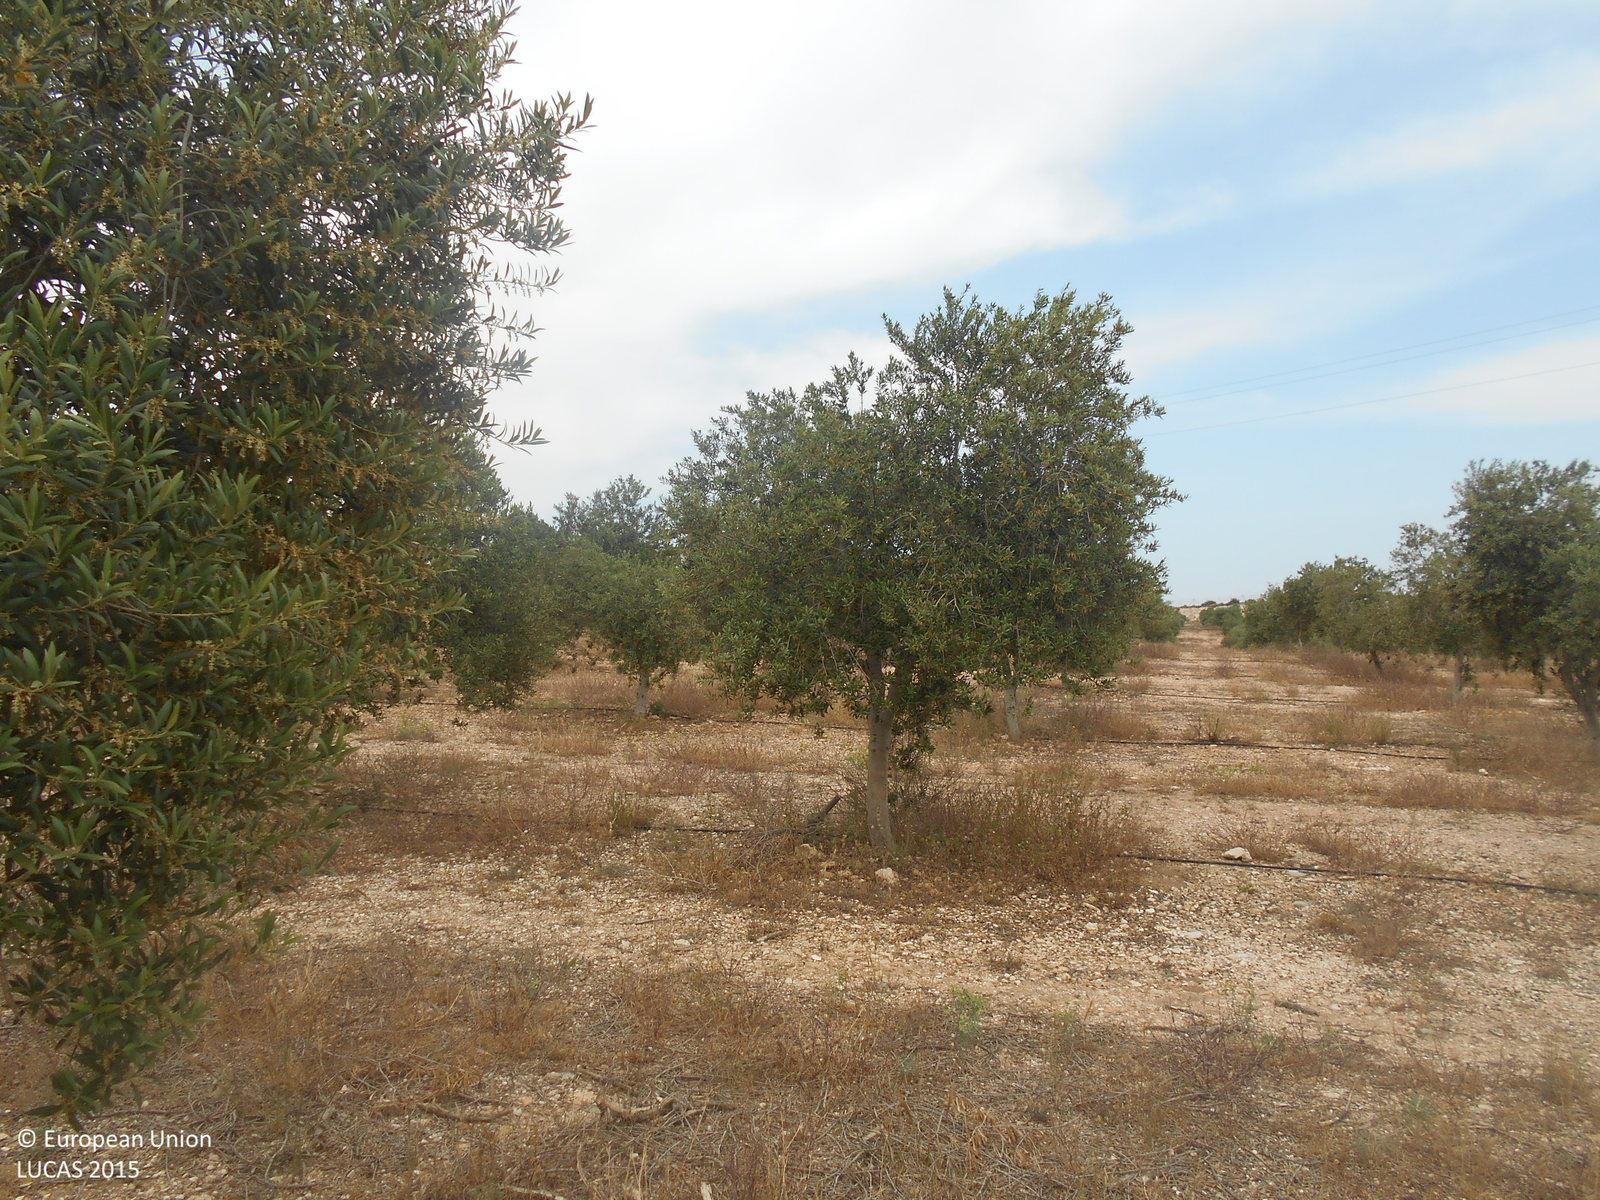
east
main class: Cropland
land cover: Olive groves
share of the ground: 25 - 50 %
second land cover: Spontaneously vegetated surfaces
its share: 10 - 25 %
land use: Agriculture (excluding fallow land and kitchen gardens)
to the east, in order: Olive groves; Spontaneously vegetated surfaces; Electric lines; Olive groves
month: May
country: ES
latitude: 37.1135
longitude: -2.2785
